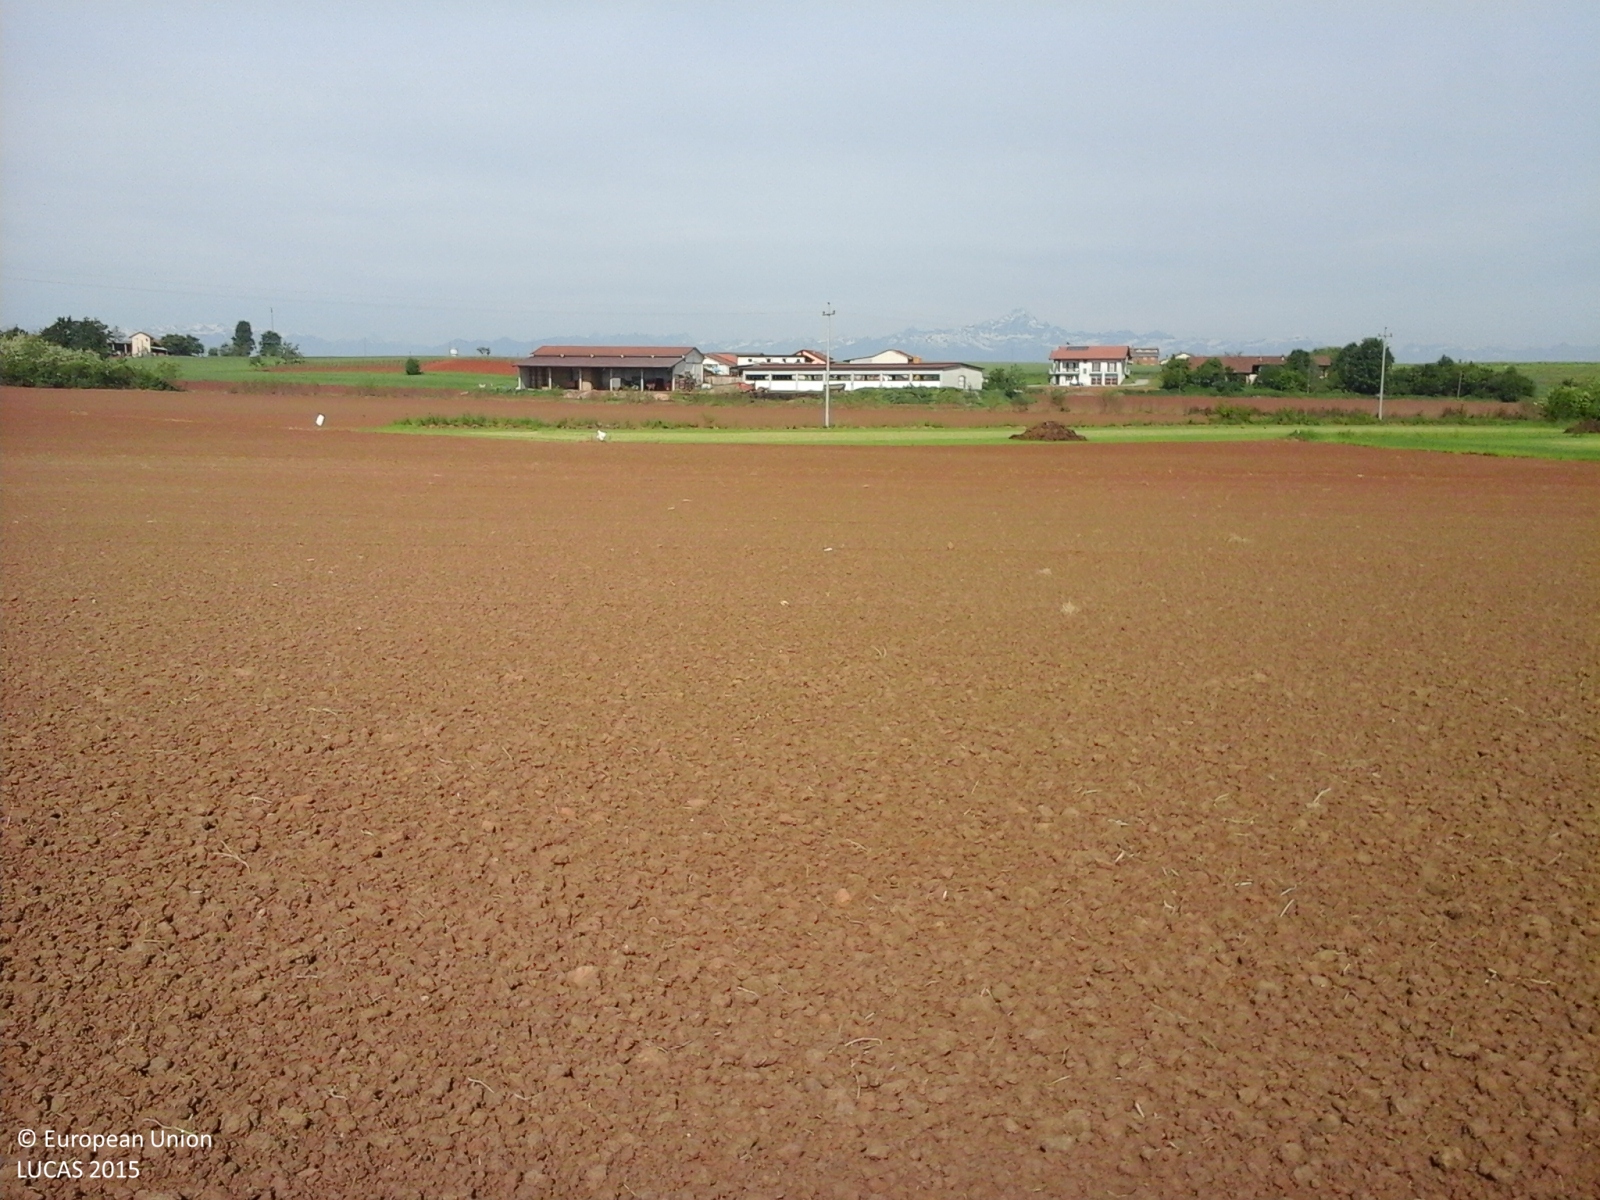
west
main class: Cropland
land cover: Maize
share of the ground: < 10 %
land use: Agriculture (excluding fallow land and kitchen gardens)
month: May
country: IT
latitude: 44.5438
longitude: 7.8019
